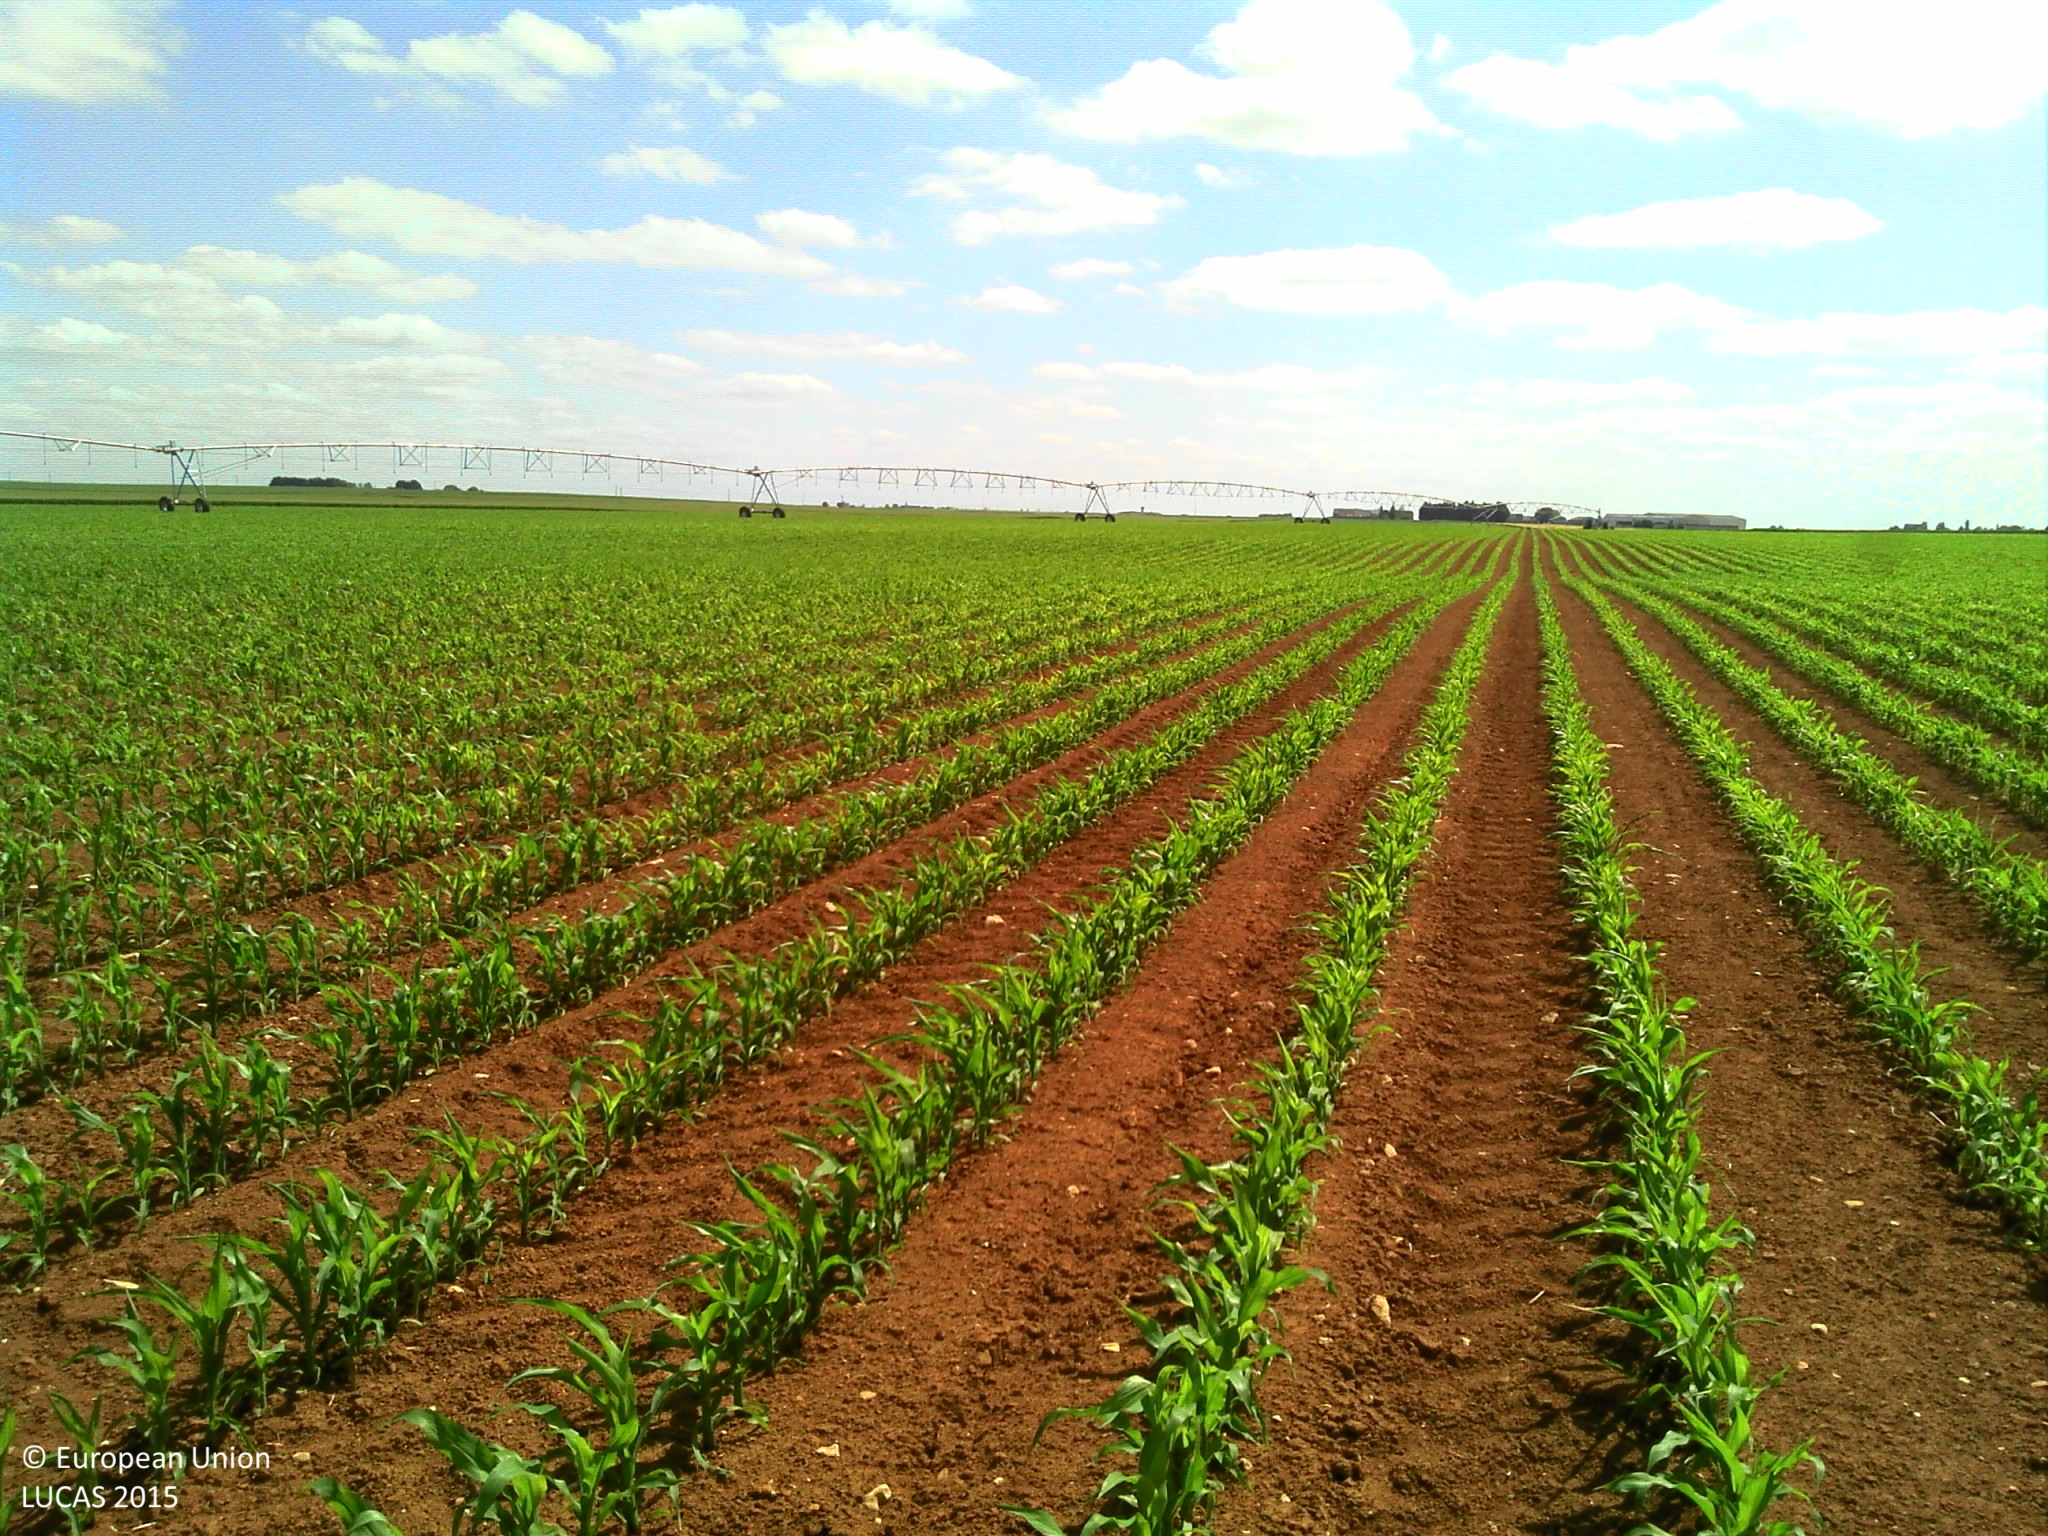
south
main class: Cropland
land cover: Maize
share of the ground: 25 - 50 %
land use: Agriculture (excluding fallow land and kitchen gardens)
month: June
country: FR
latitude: 48.0570
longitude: 1.4911
